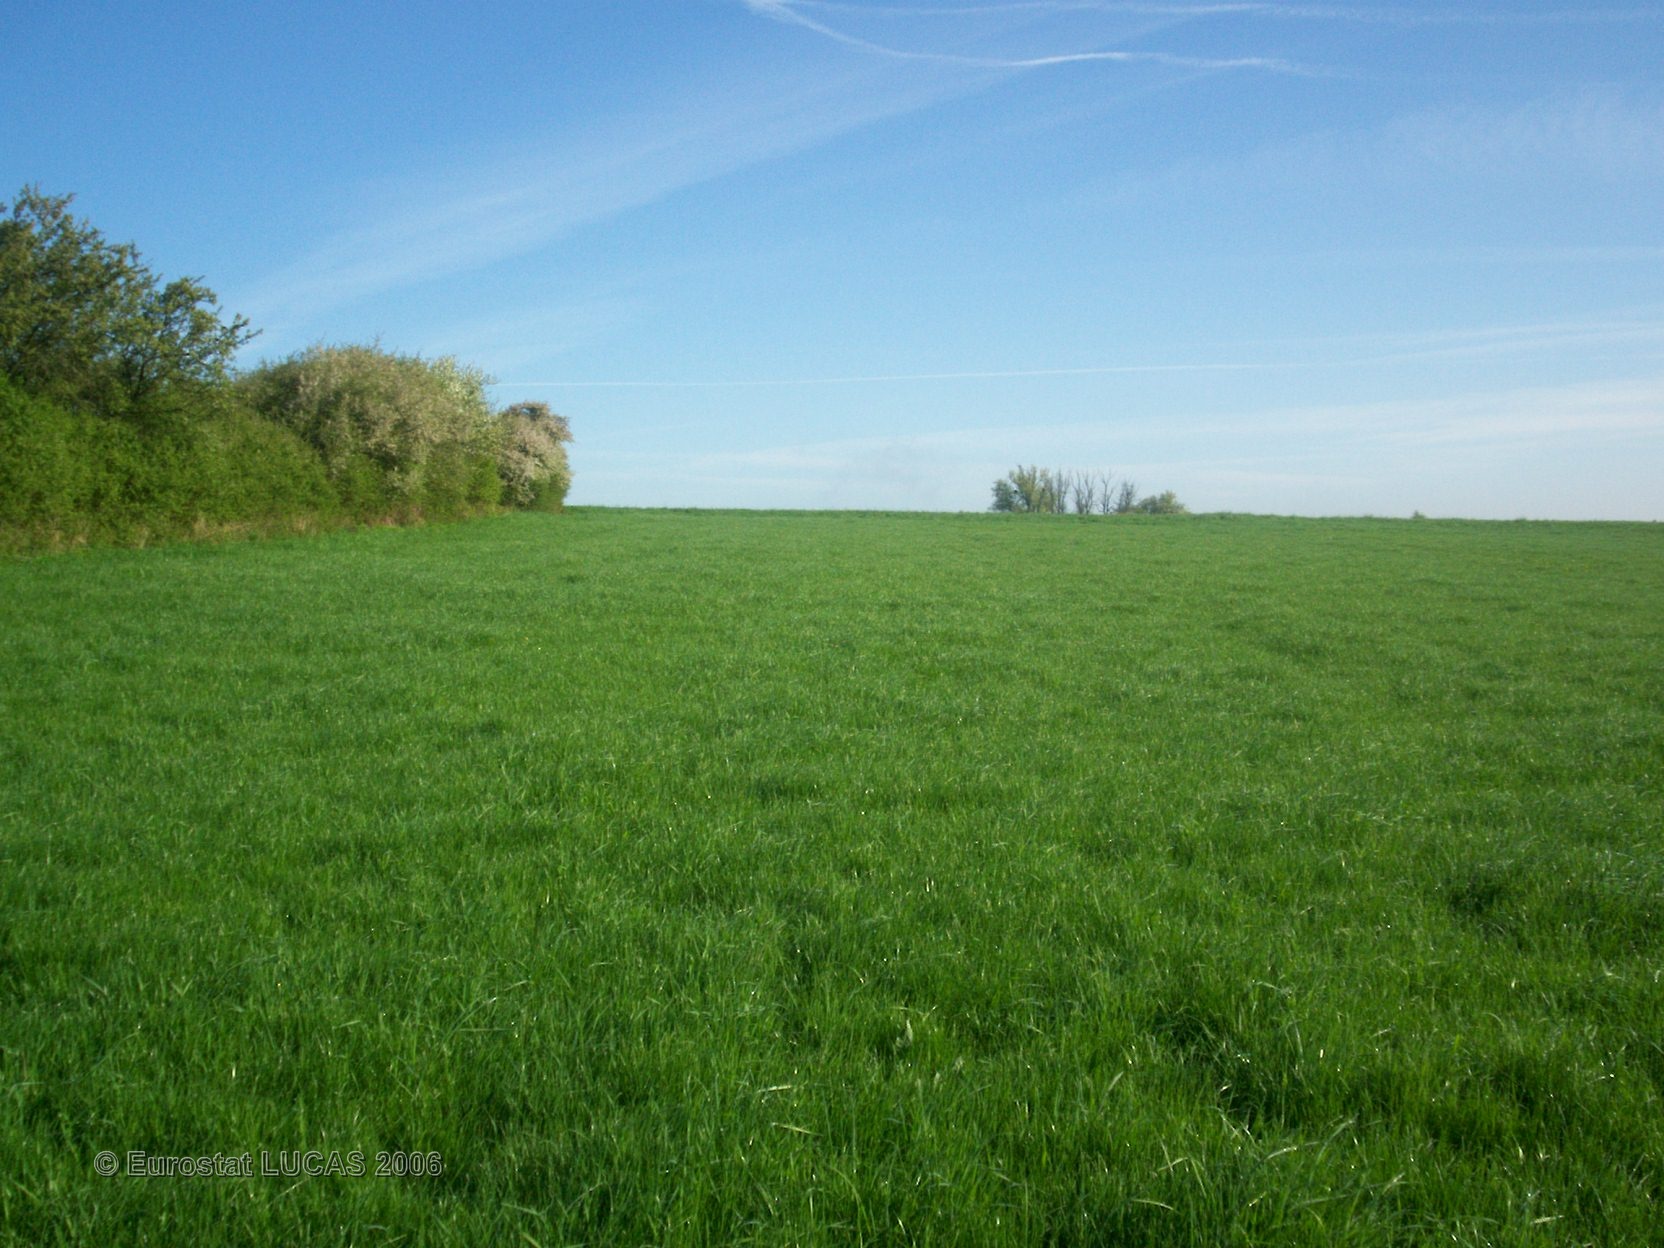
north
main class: Grassland
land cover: Grassland without tree/shrub cover
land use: Agriculture (excluding fallow land and kitchen gardens)
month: May
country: FR
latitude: 49.0987
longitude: 6.9187
